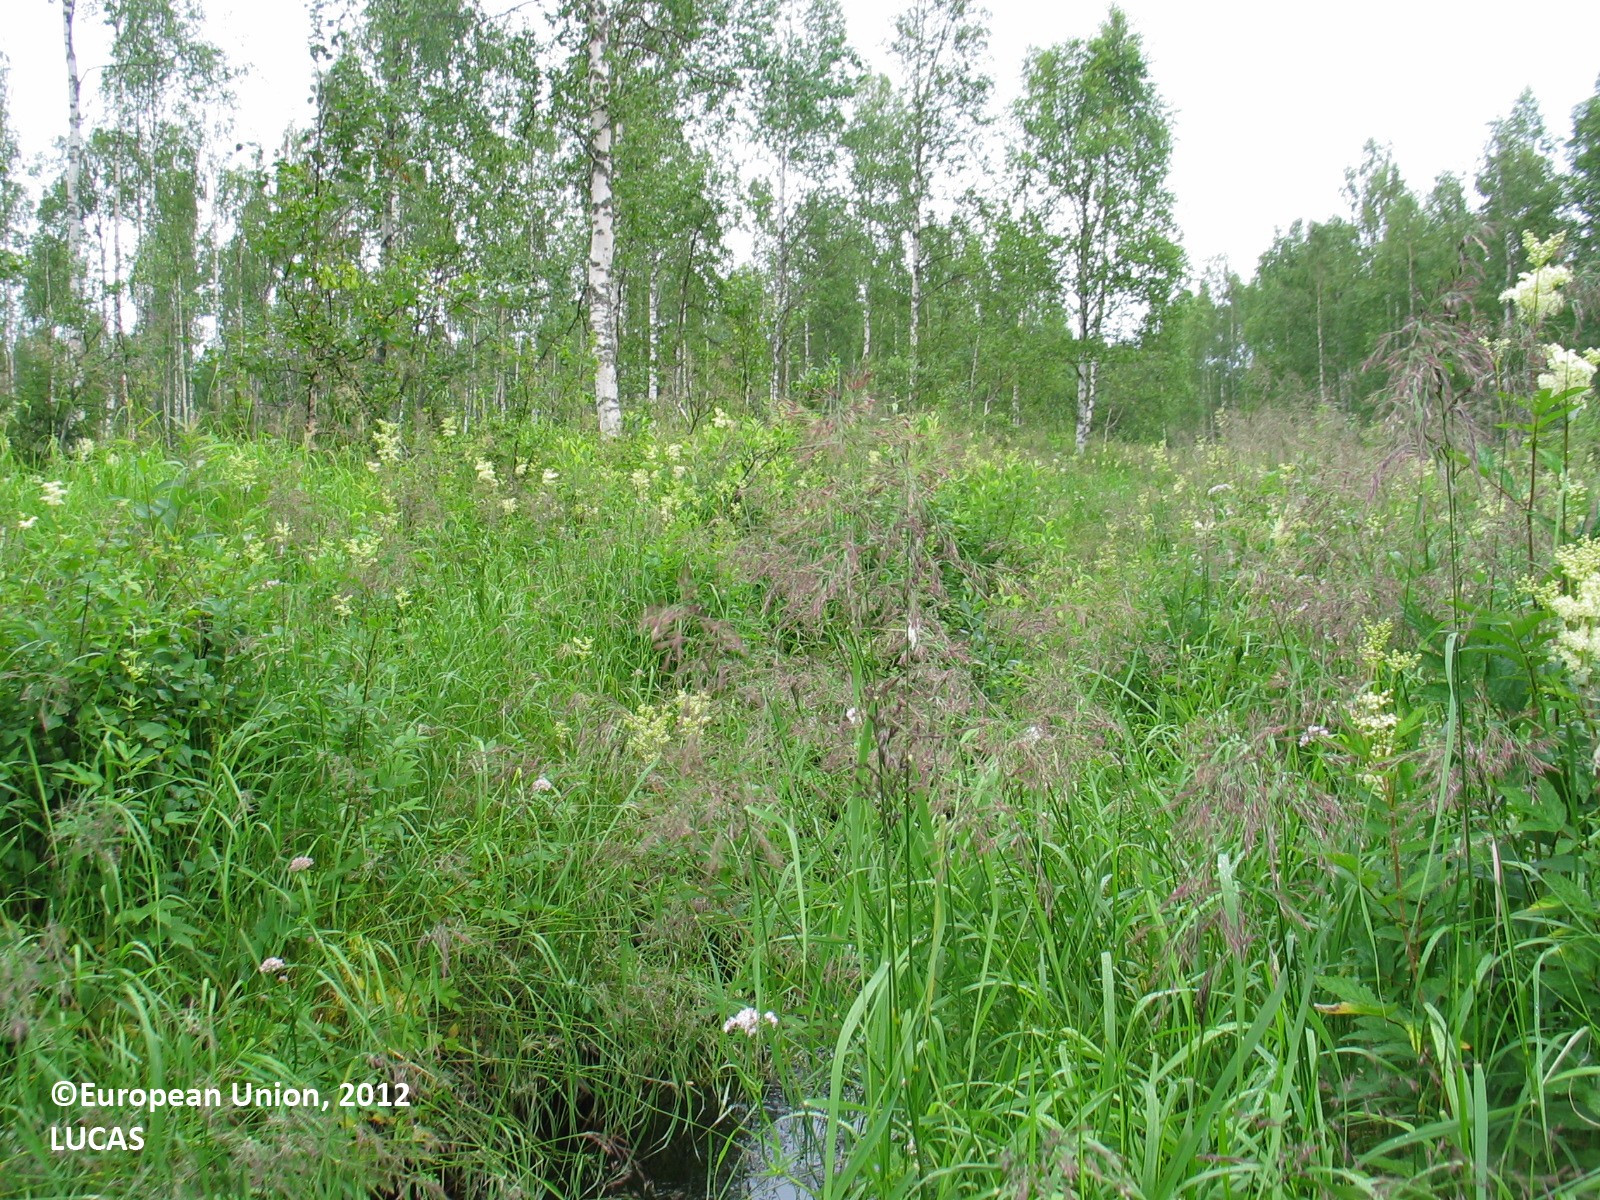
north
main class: Grassland
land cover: Spontaneously vegetated surfaces
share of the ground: > 75 %
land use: Forestry
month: July
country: FI
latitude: 65.8511
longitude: 25.2929
